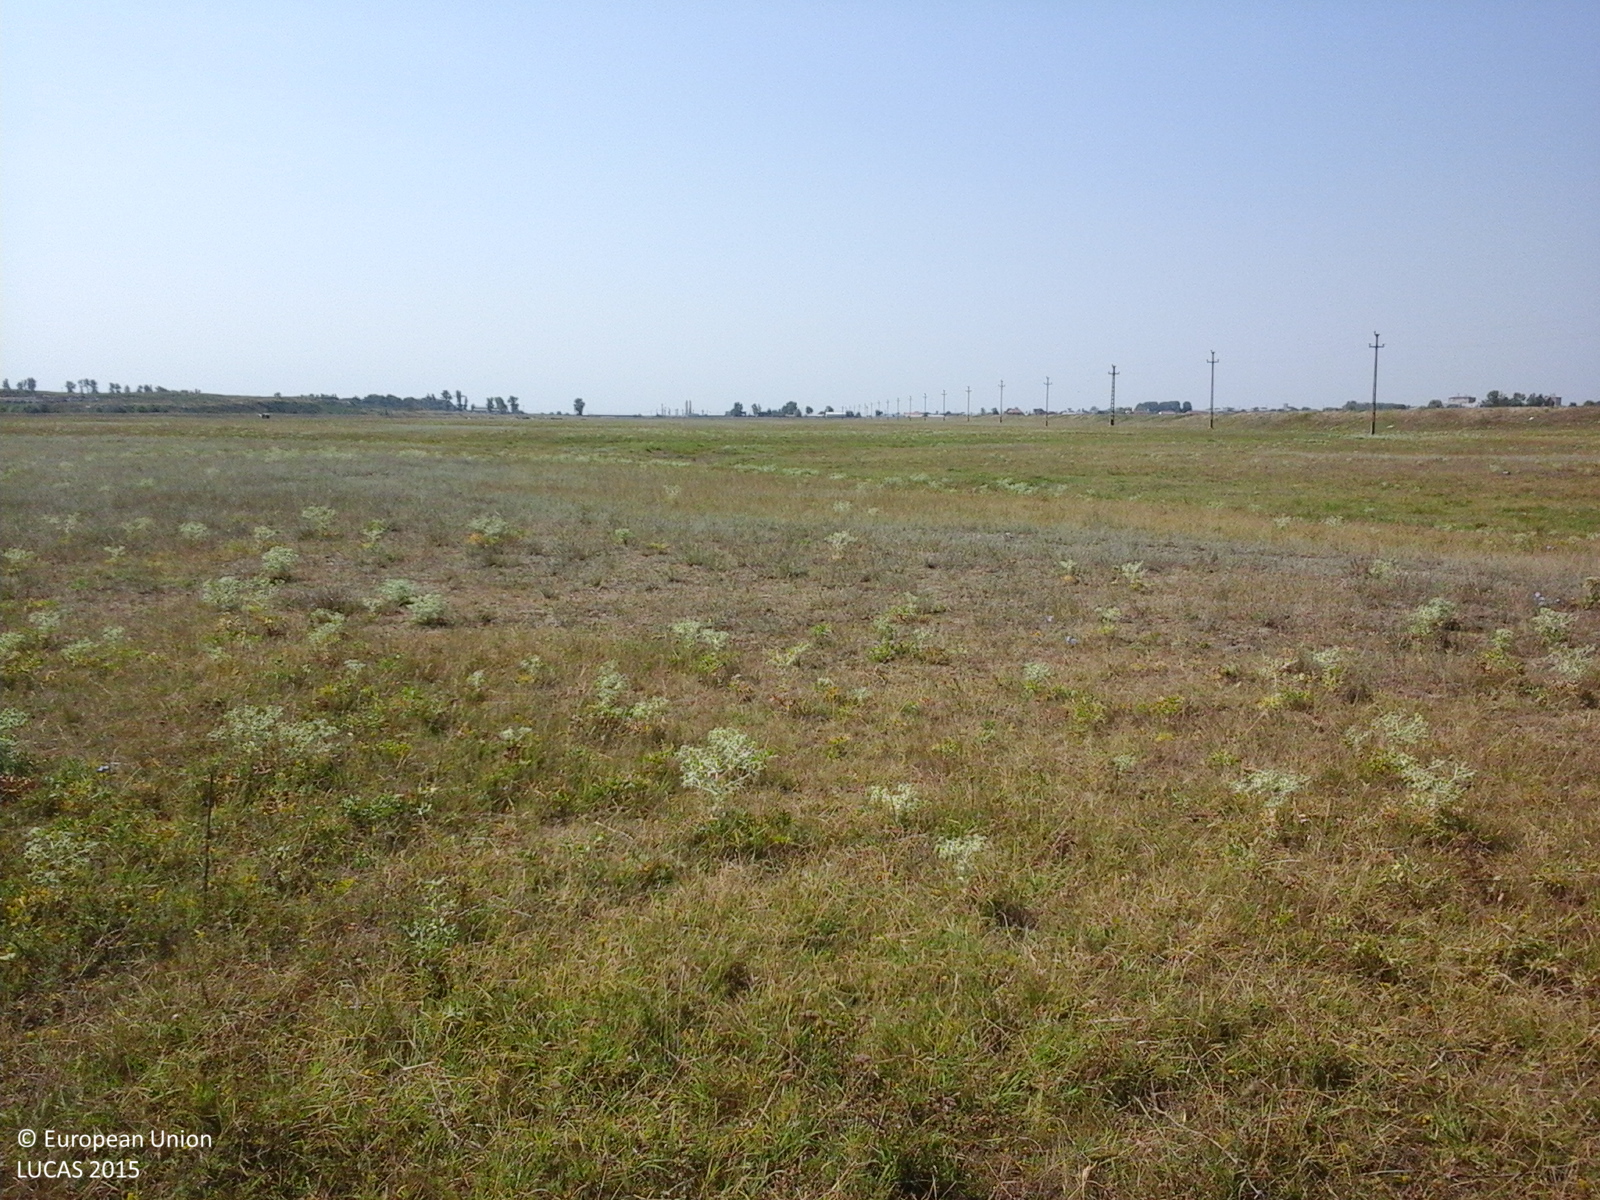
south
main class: Grassland
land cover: Grassland without tree/shrub cover
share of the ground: > 75 %
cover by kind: herbaceous plants 100 %
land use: Agriculture (excluding fallow land and kitchen gardens)
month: July
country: RO
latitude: 45.8593
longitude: 27.4532
